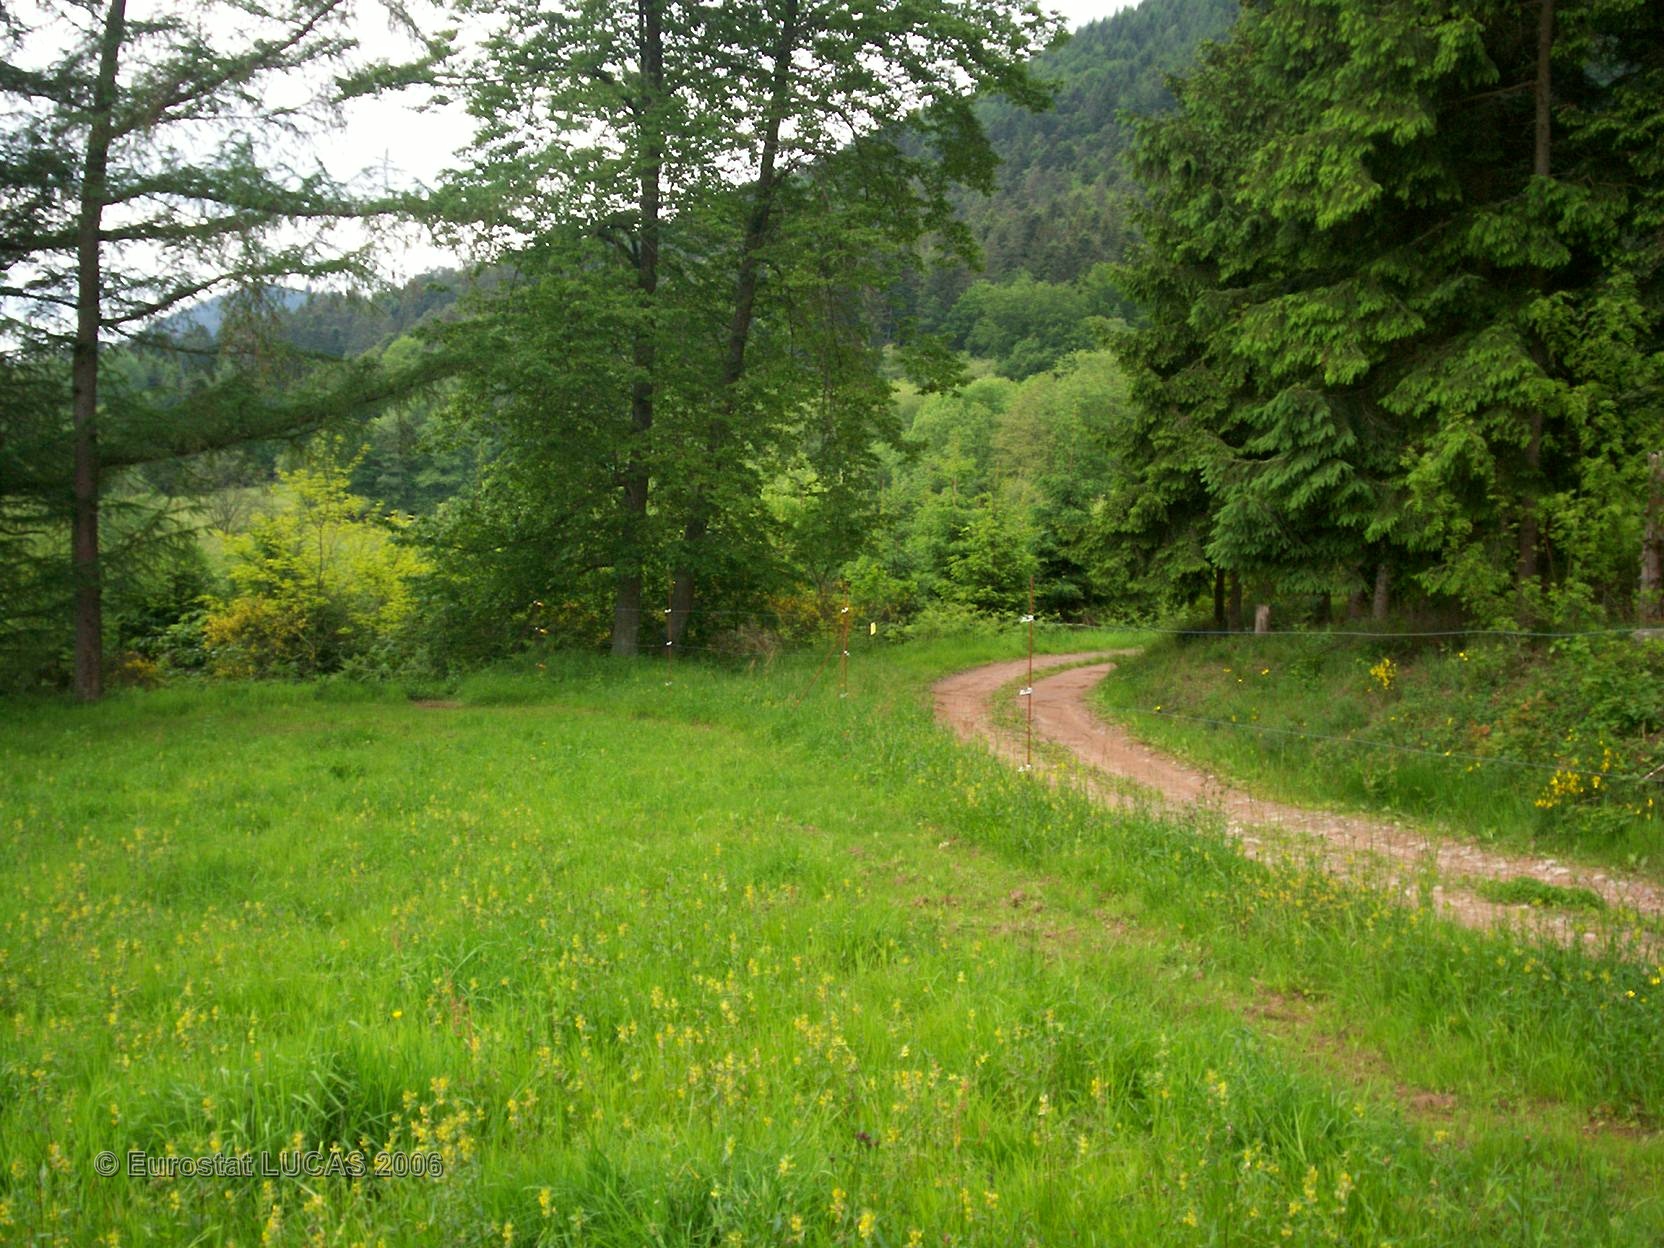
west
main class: Grassland
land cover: Grassland without tree/shrub cover
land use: Agriculture (excluding fallow land and kitchen gardens)
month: June
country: FR
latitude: 48.3978
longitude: 6.9618
